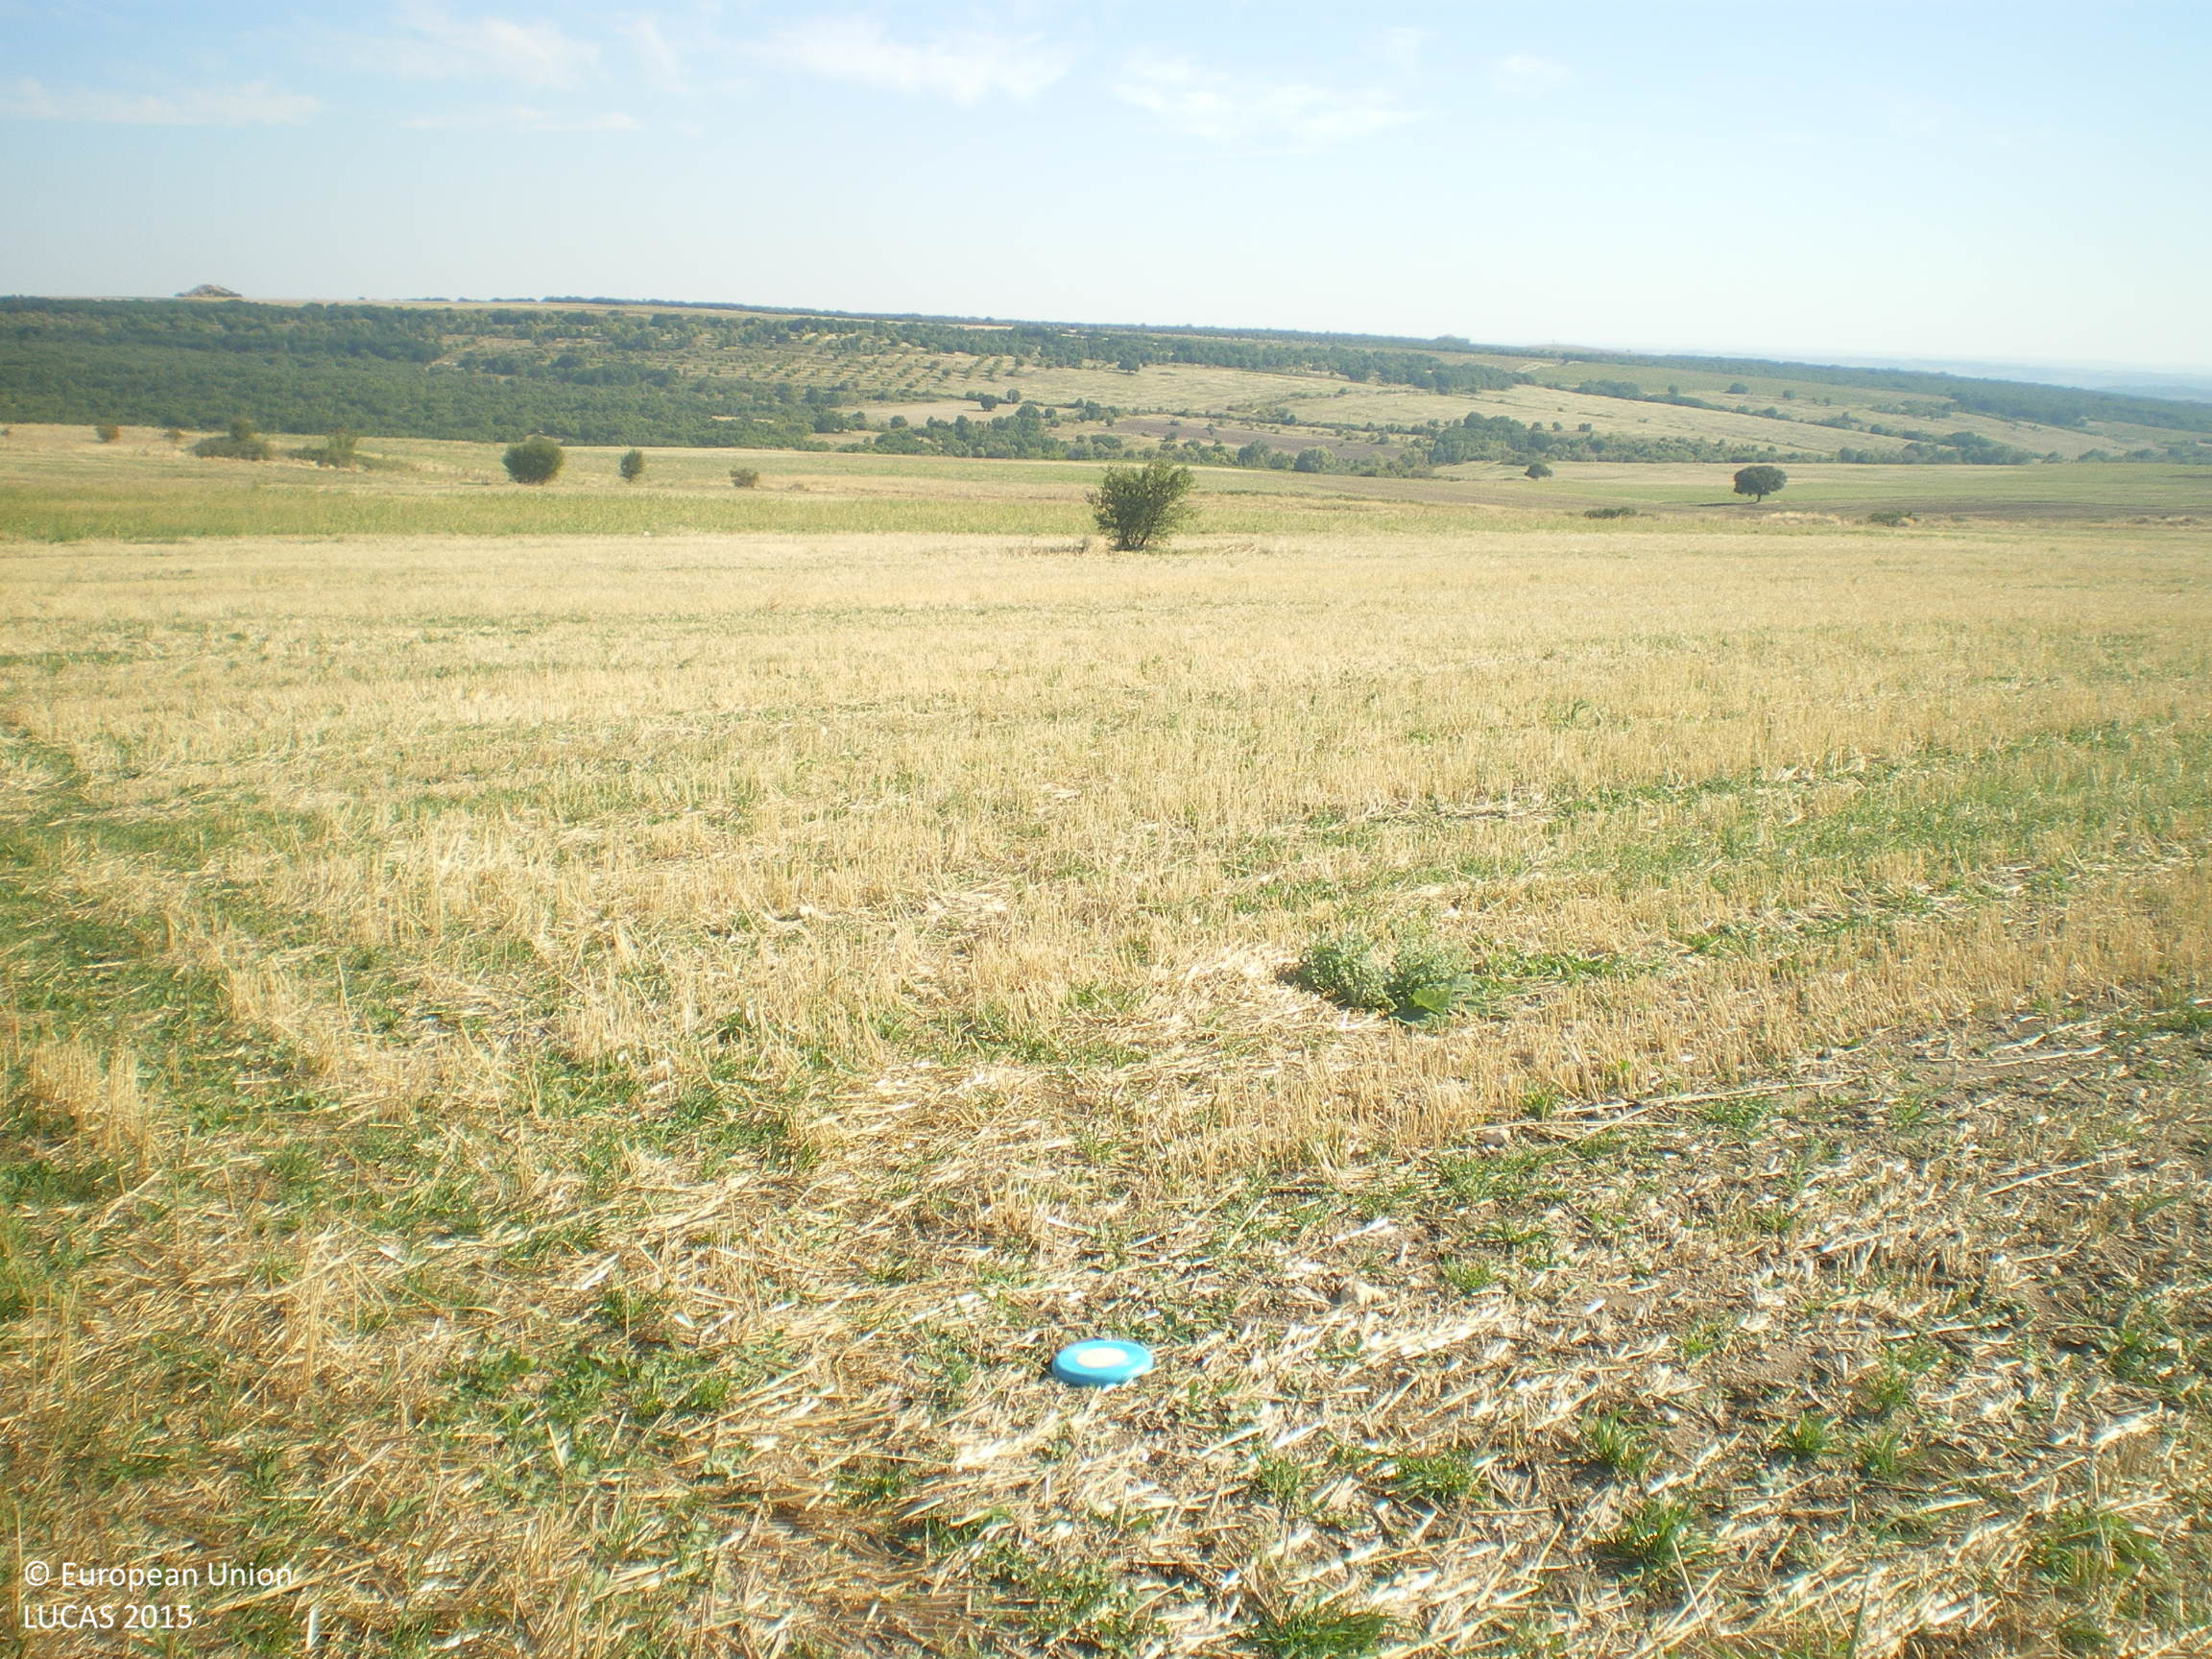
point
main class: Cropland
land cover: Common wheat
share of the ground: 10 - 25 %
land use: Agriculture (excluding fallow land and kitchen gardens)
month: September
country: BG
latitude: 41.8342
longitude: 26.3235
